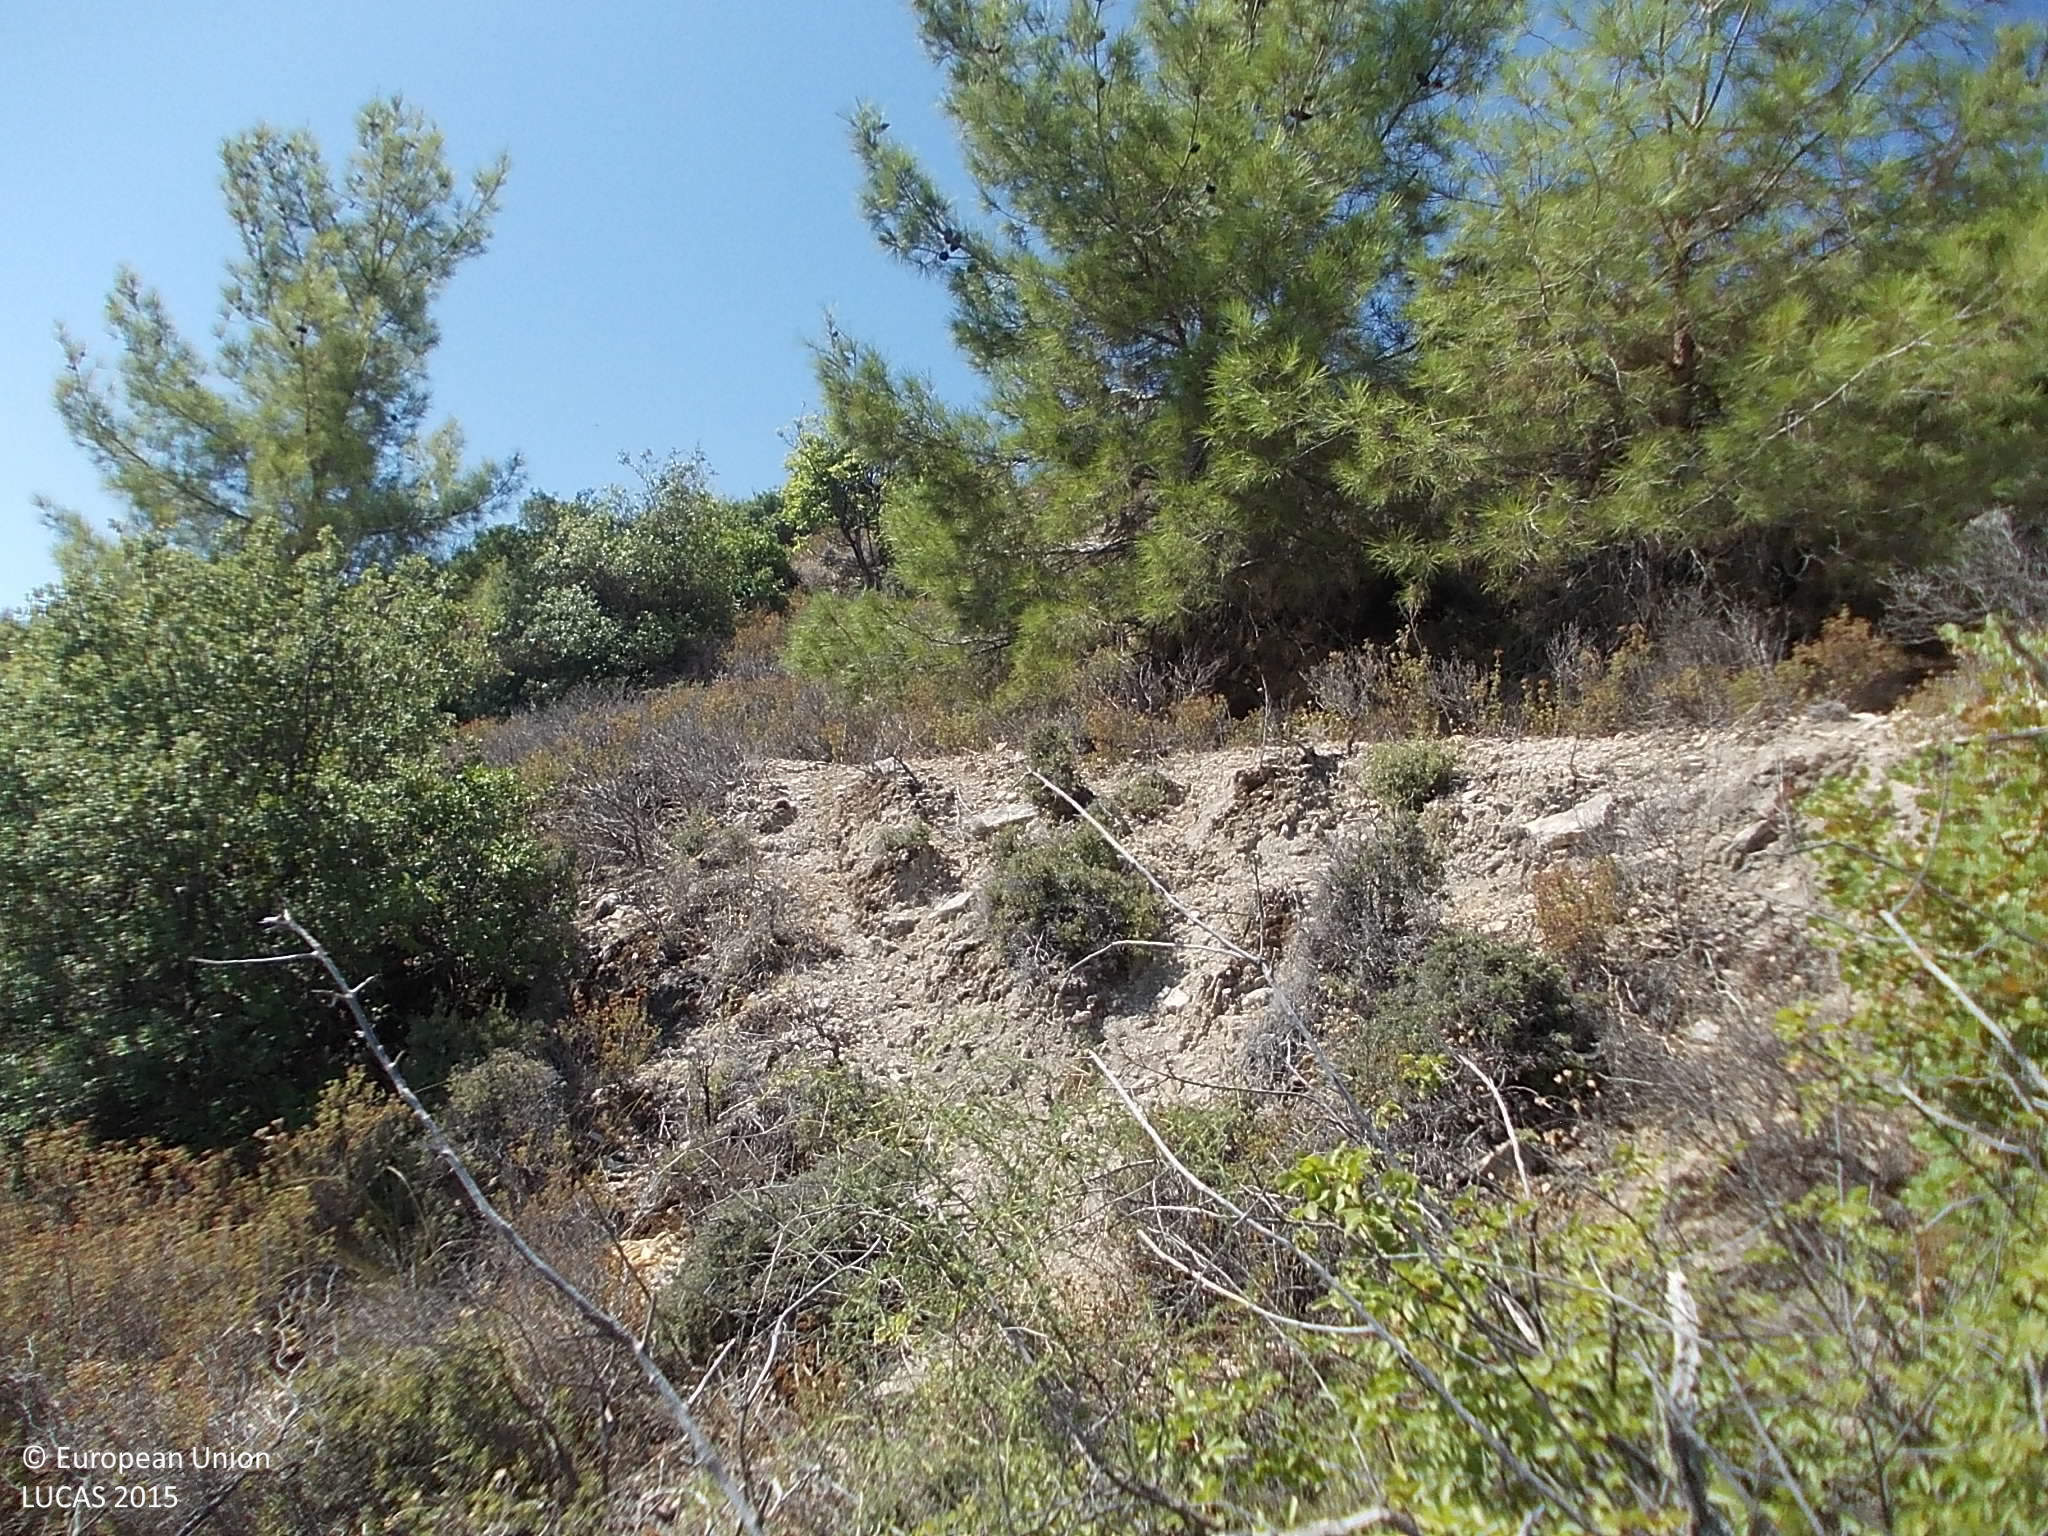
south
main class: Shrubland
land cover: Shrubland with sparse tree cover
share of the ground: > 75 %
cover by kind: shrubs 90 %, coniferous forest trees 5 %, unconsolidated bare surface 5 %
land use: Semi-natural and natural areas not in use
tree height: > 5 m
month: August
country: CY
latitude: 34.7811
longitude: 32.9034
